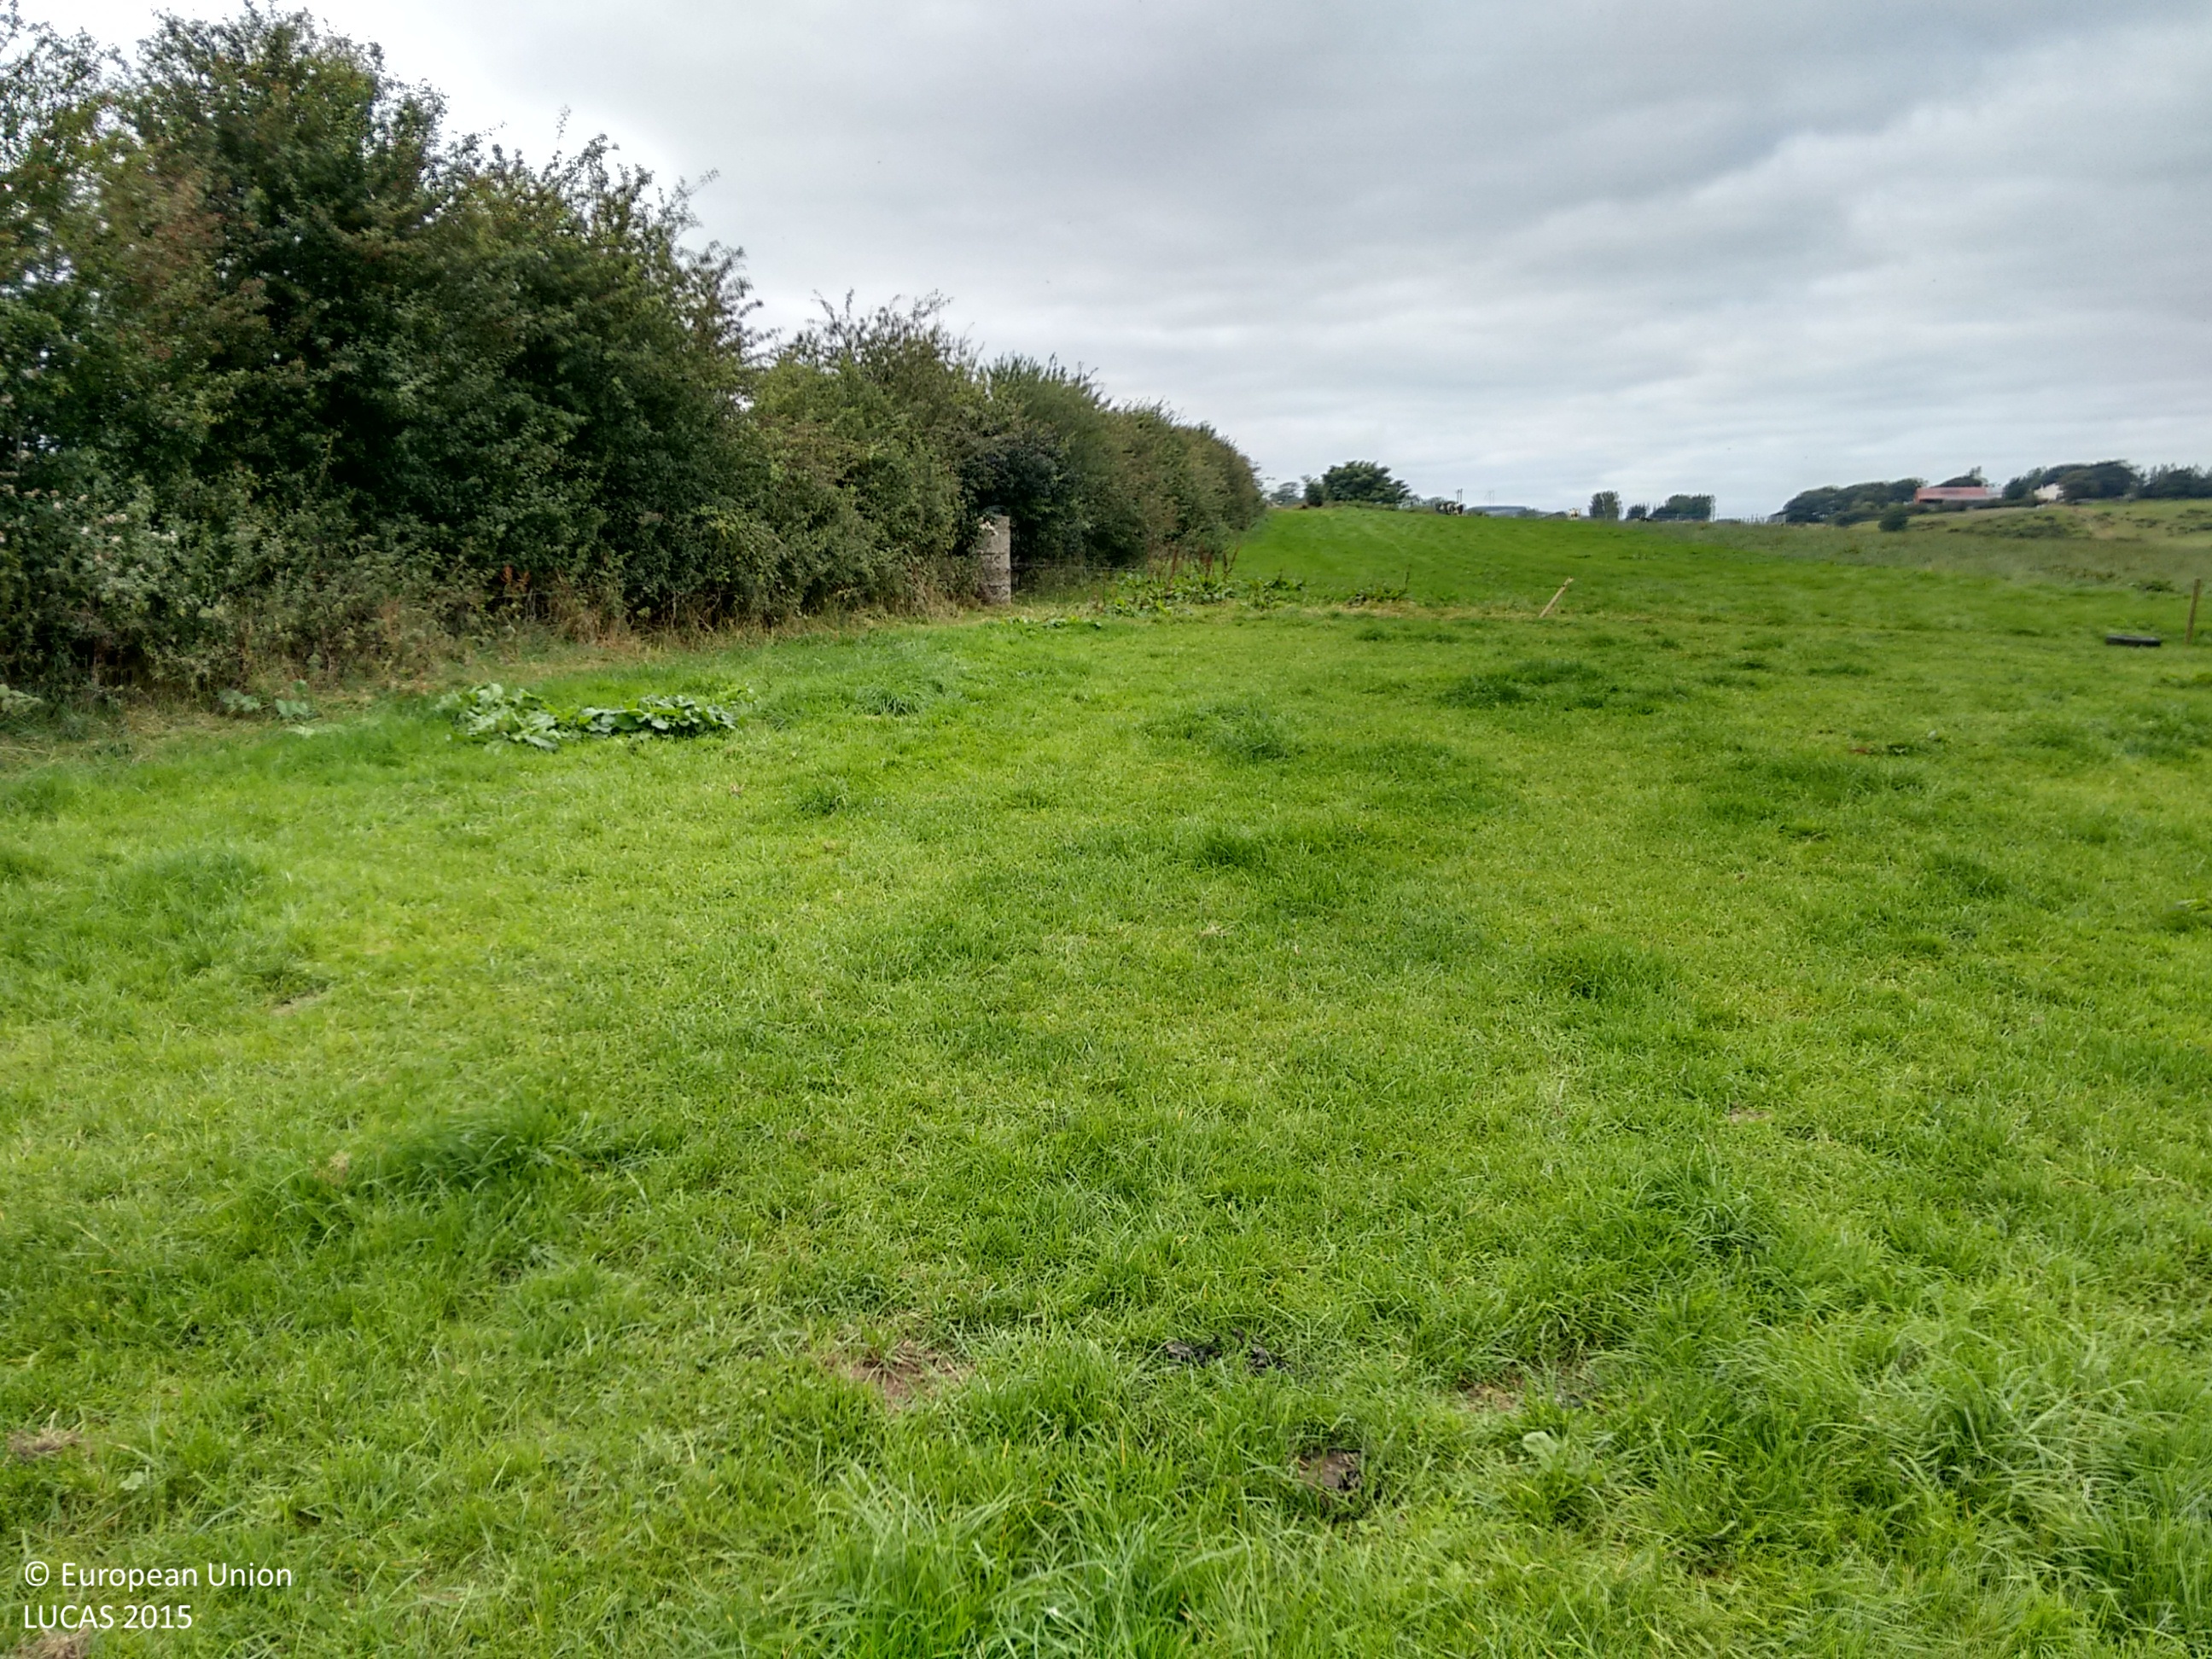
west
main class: Grassland
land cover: Grassland without tree/shrub cover
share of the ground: > 75 %
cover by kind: herbaceous plants 100 %
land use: Agriculture (excluding fallow land and kitchen gardens)
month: September
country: IE
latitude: 52.5232
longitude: -9.0049
